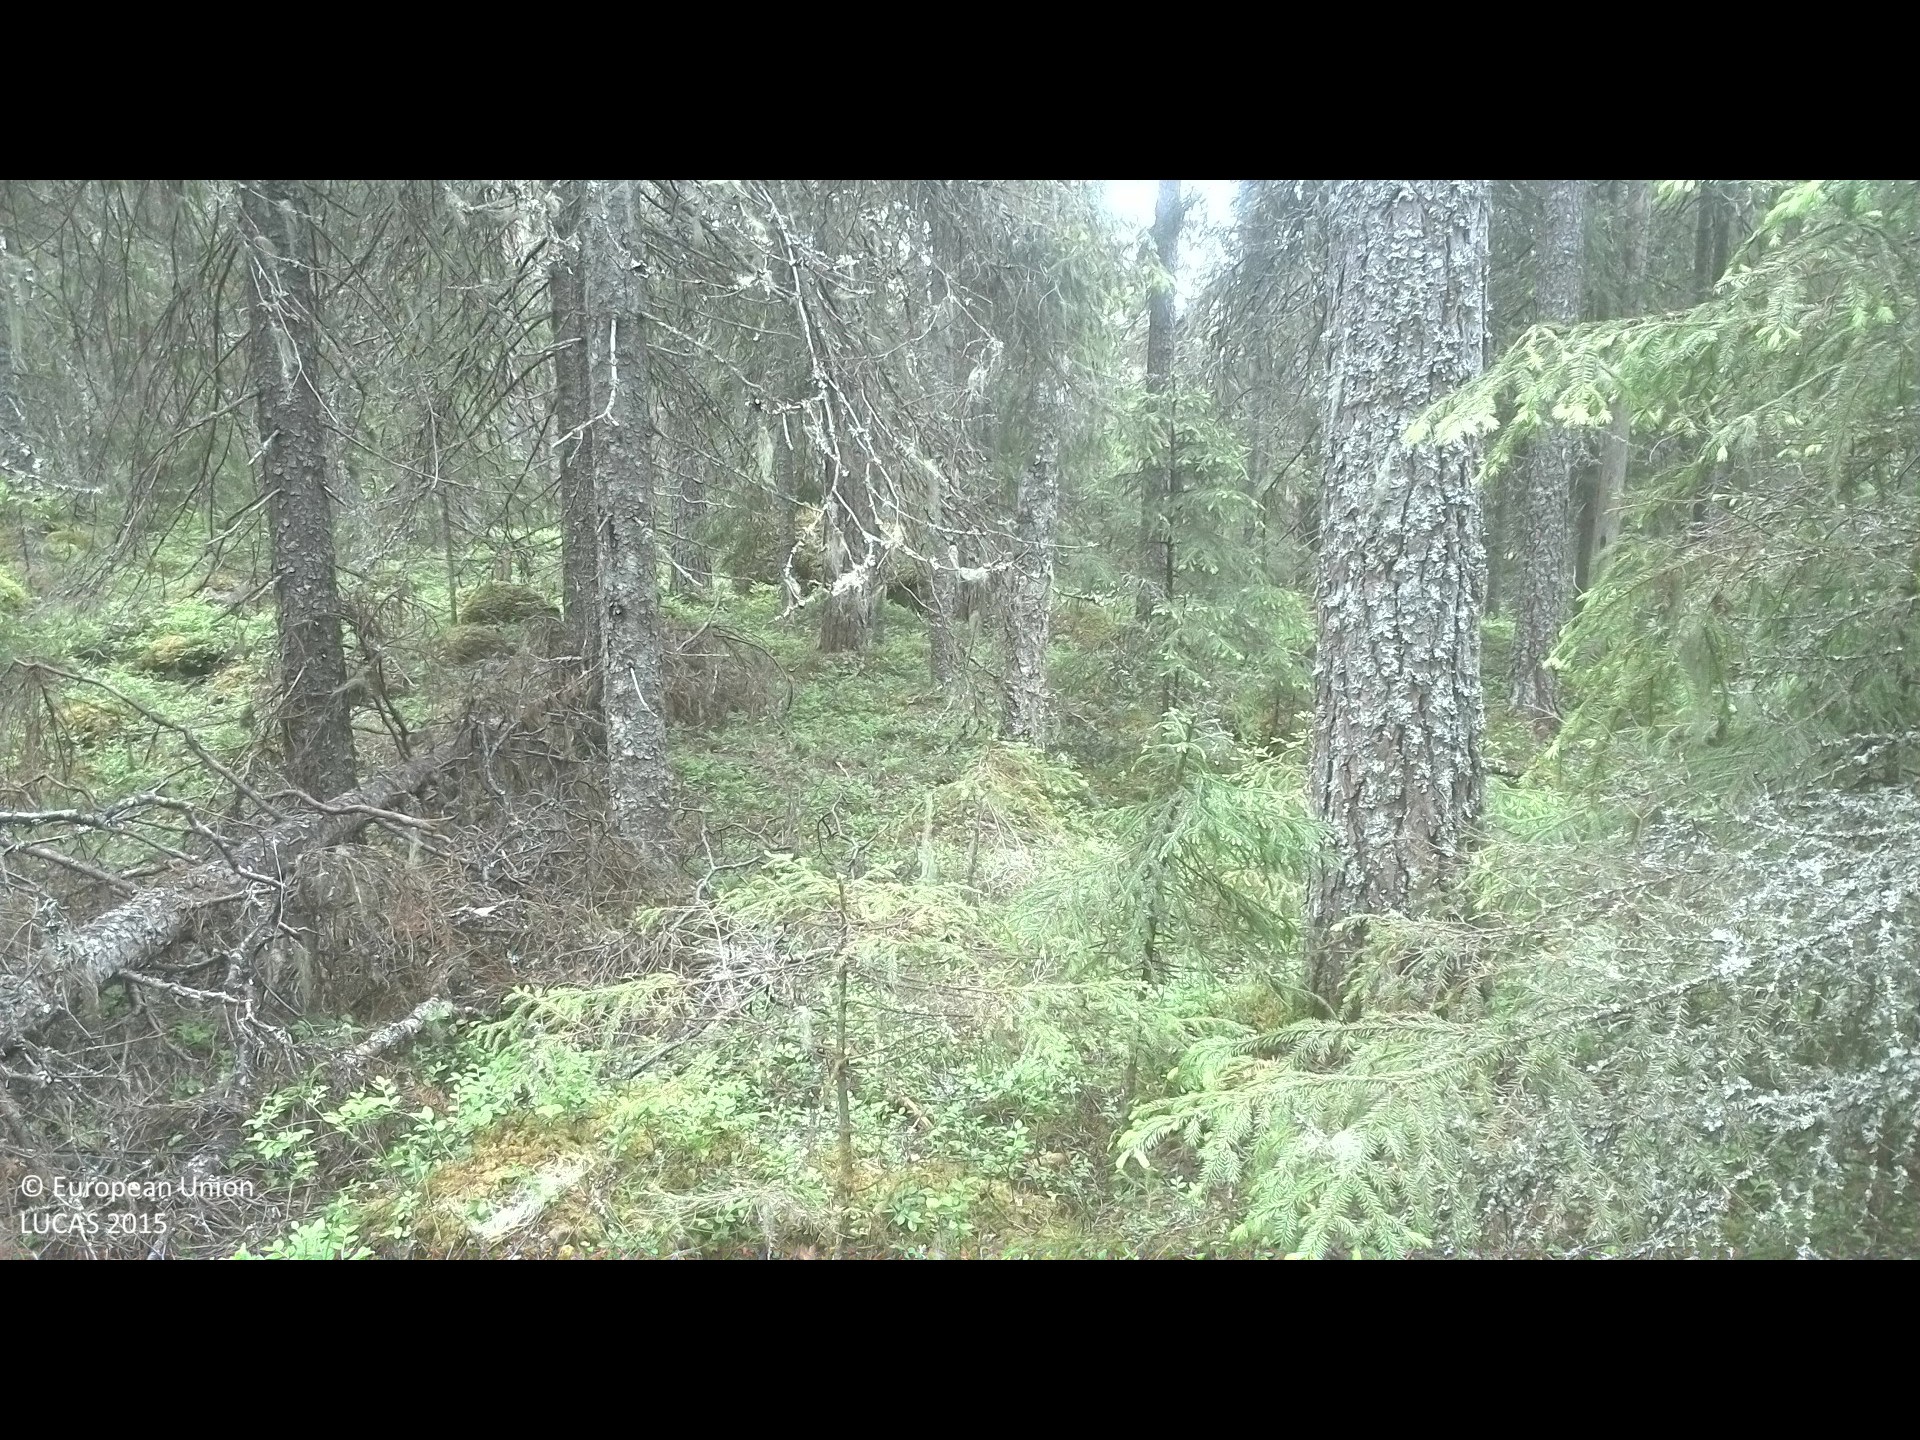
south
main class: Woodland
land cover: Spruce dominated coniferous woodland
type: boreal forest
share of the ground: 50 - 75 %
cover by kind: coniferous forest trees 50 %, shrubs 25 %, lichens and mosses 20 %, herbaceous plants 5 %
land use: Forestry
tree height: > 5 m
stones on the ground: 25 - 50 %
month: June
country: SE
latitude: 62.0565
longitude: 16.8874
